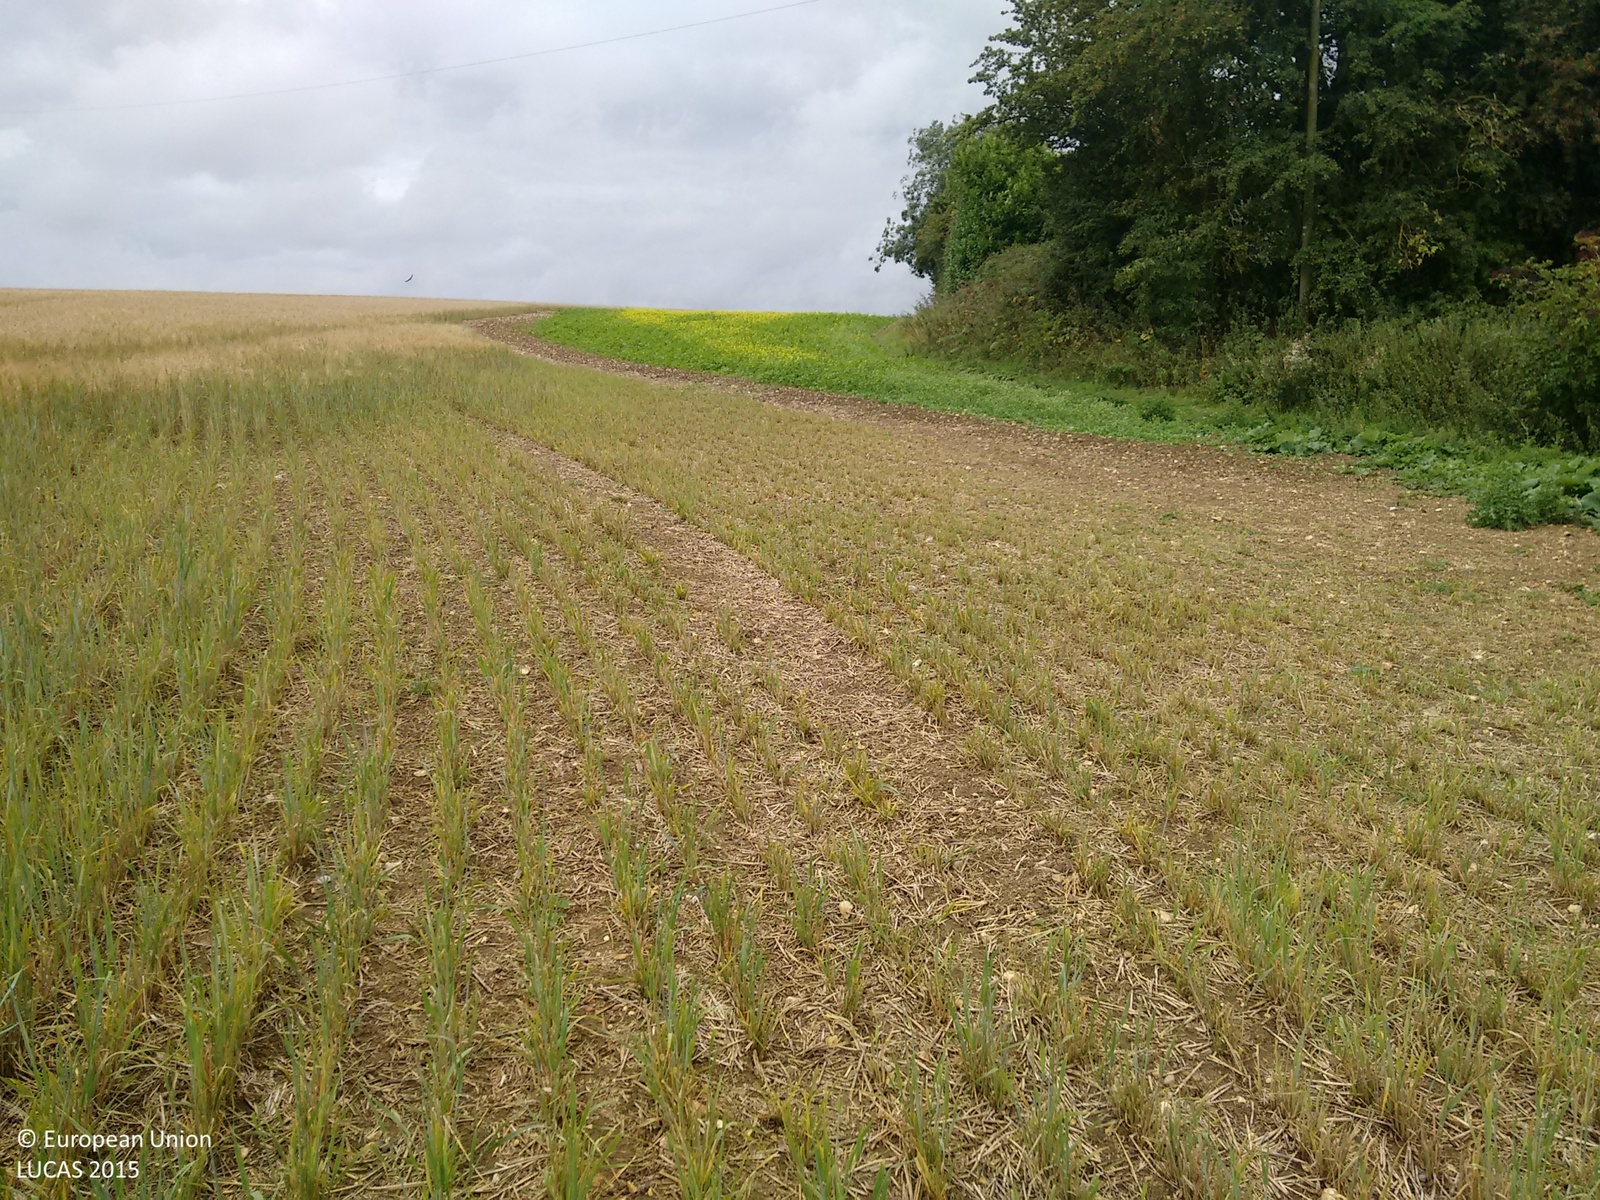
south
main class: Cropland
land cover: Barley
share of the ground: > 75 %
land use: Agriculture (excluding fallow land and kitchen gardens)
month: August
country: GB
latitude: 52.0530
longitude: 0.5373
